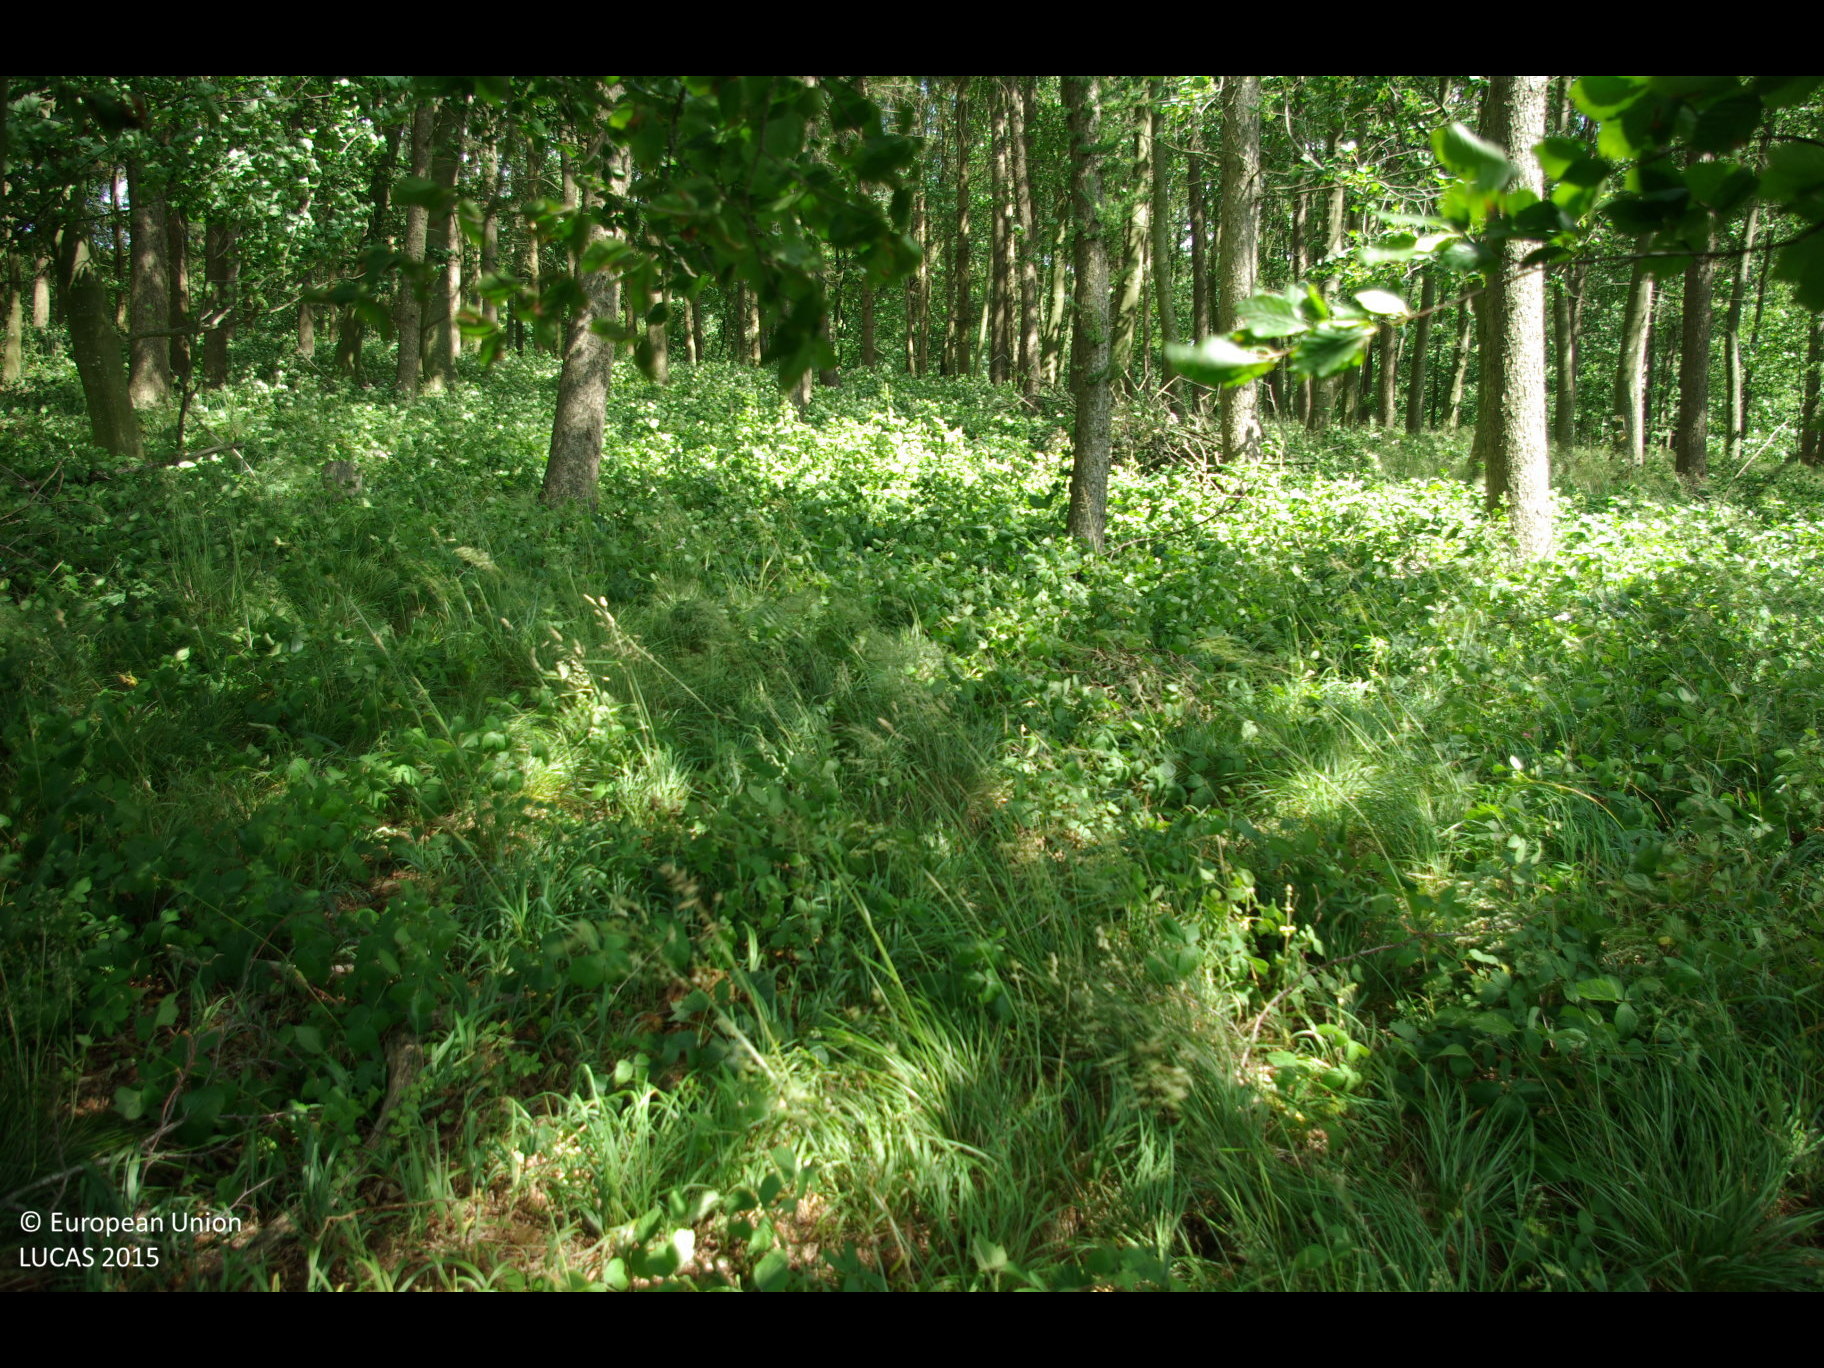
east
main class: Woodland
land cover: Other mixed woodland
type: hemiboreal forest and nemoral coniferous forest and mixed broadleaved-coniferous forest
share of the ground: > 75 %
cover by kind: coniferous forest trees 40 %, broadleaved forest trees 40 %, herbaceous plants 20 %
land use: Forestry
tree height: > 5 m
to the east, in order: Other mixed woodland; Broadleaved woodland; Rivers and streams; Shruby margins; Tracks; Broadleaved woodland; Inland fresh water bodies; Broadleaved woodland; Spontaneously vegetated surfaces; Tracks; Broadleaved woodland
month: July
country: DE
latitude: 54.5701
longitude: 9.8918
